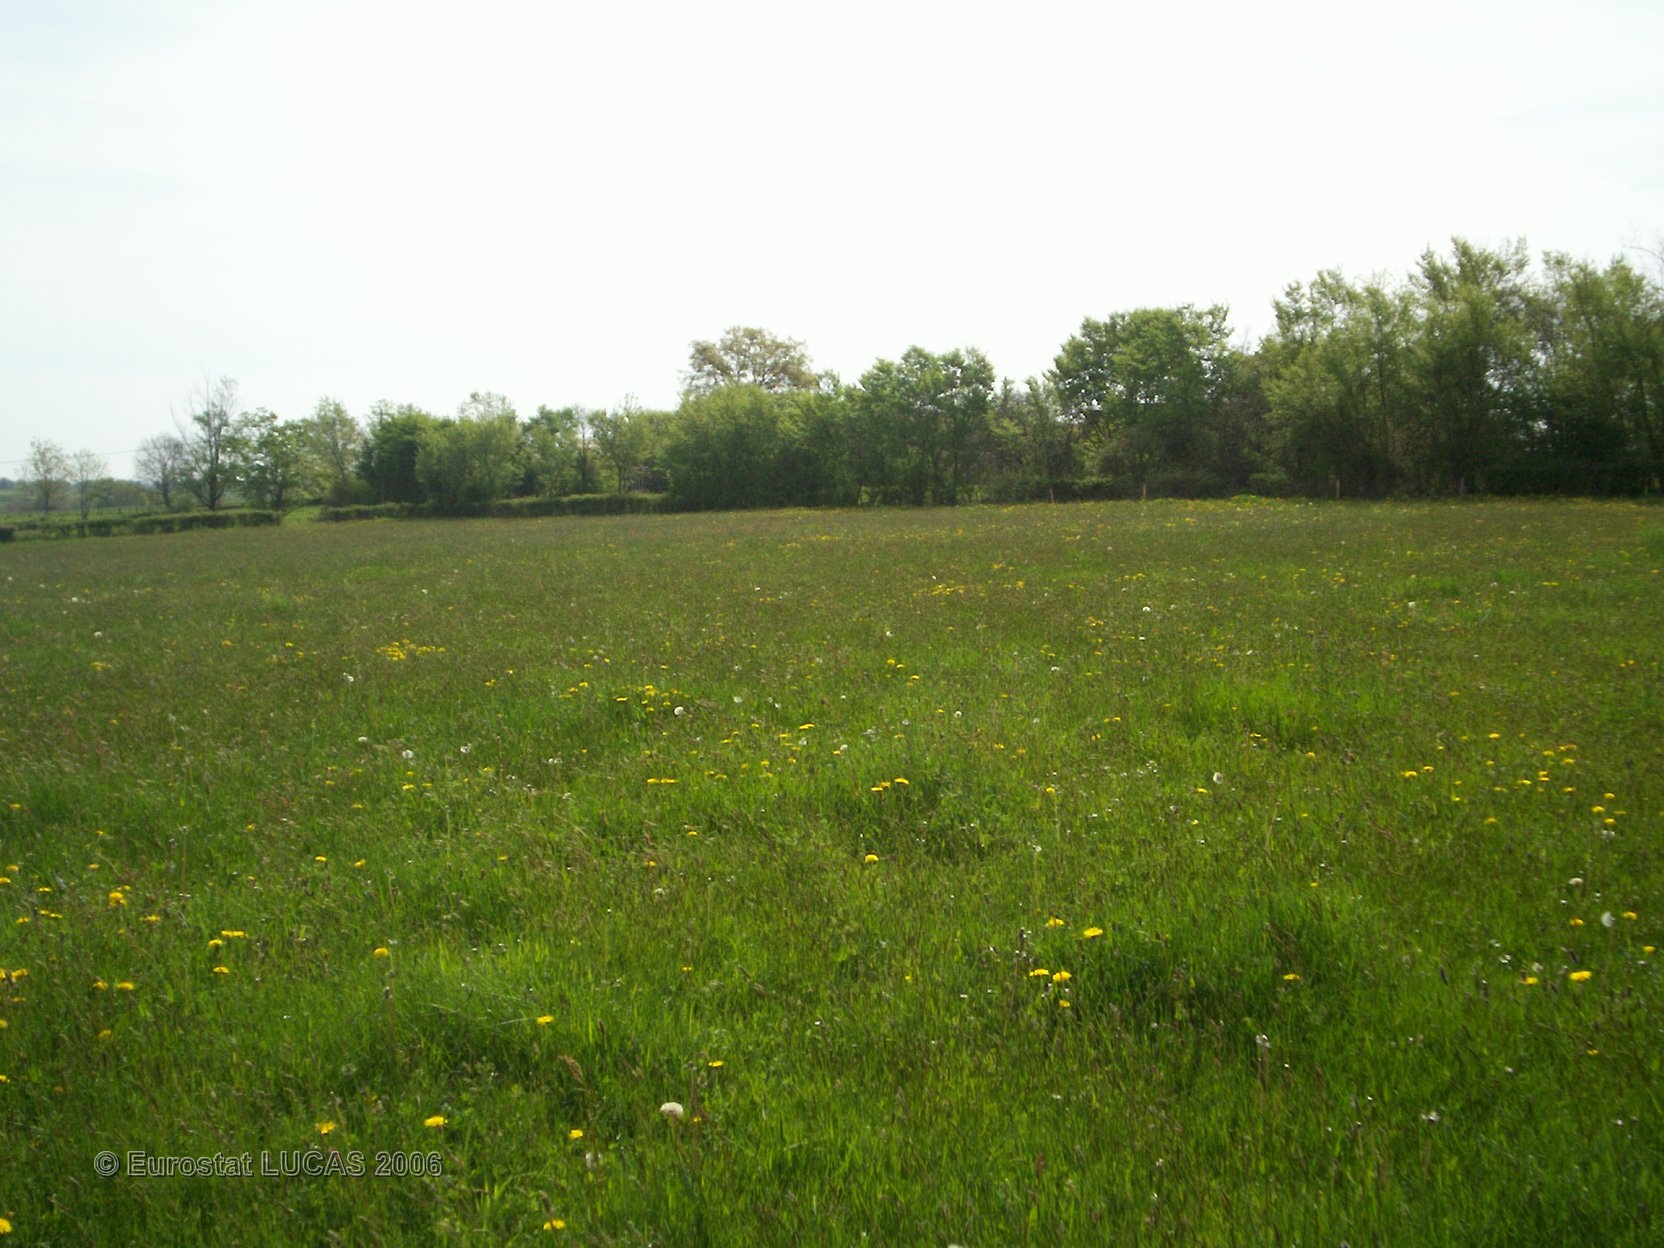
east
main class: Grassland
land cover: Grassland without tree/shrub cover
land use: Agriculture (excluding fallow land and kitchen gardens)
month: May
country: FR
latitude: 46.3321
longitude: 3.1783
